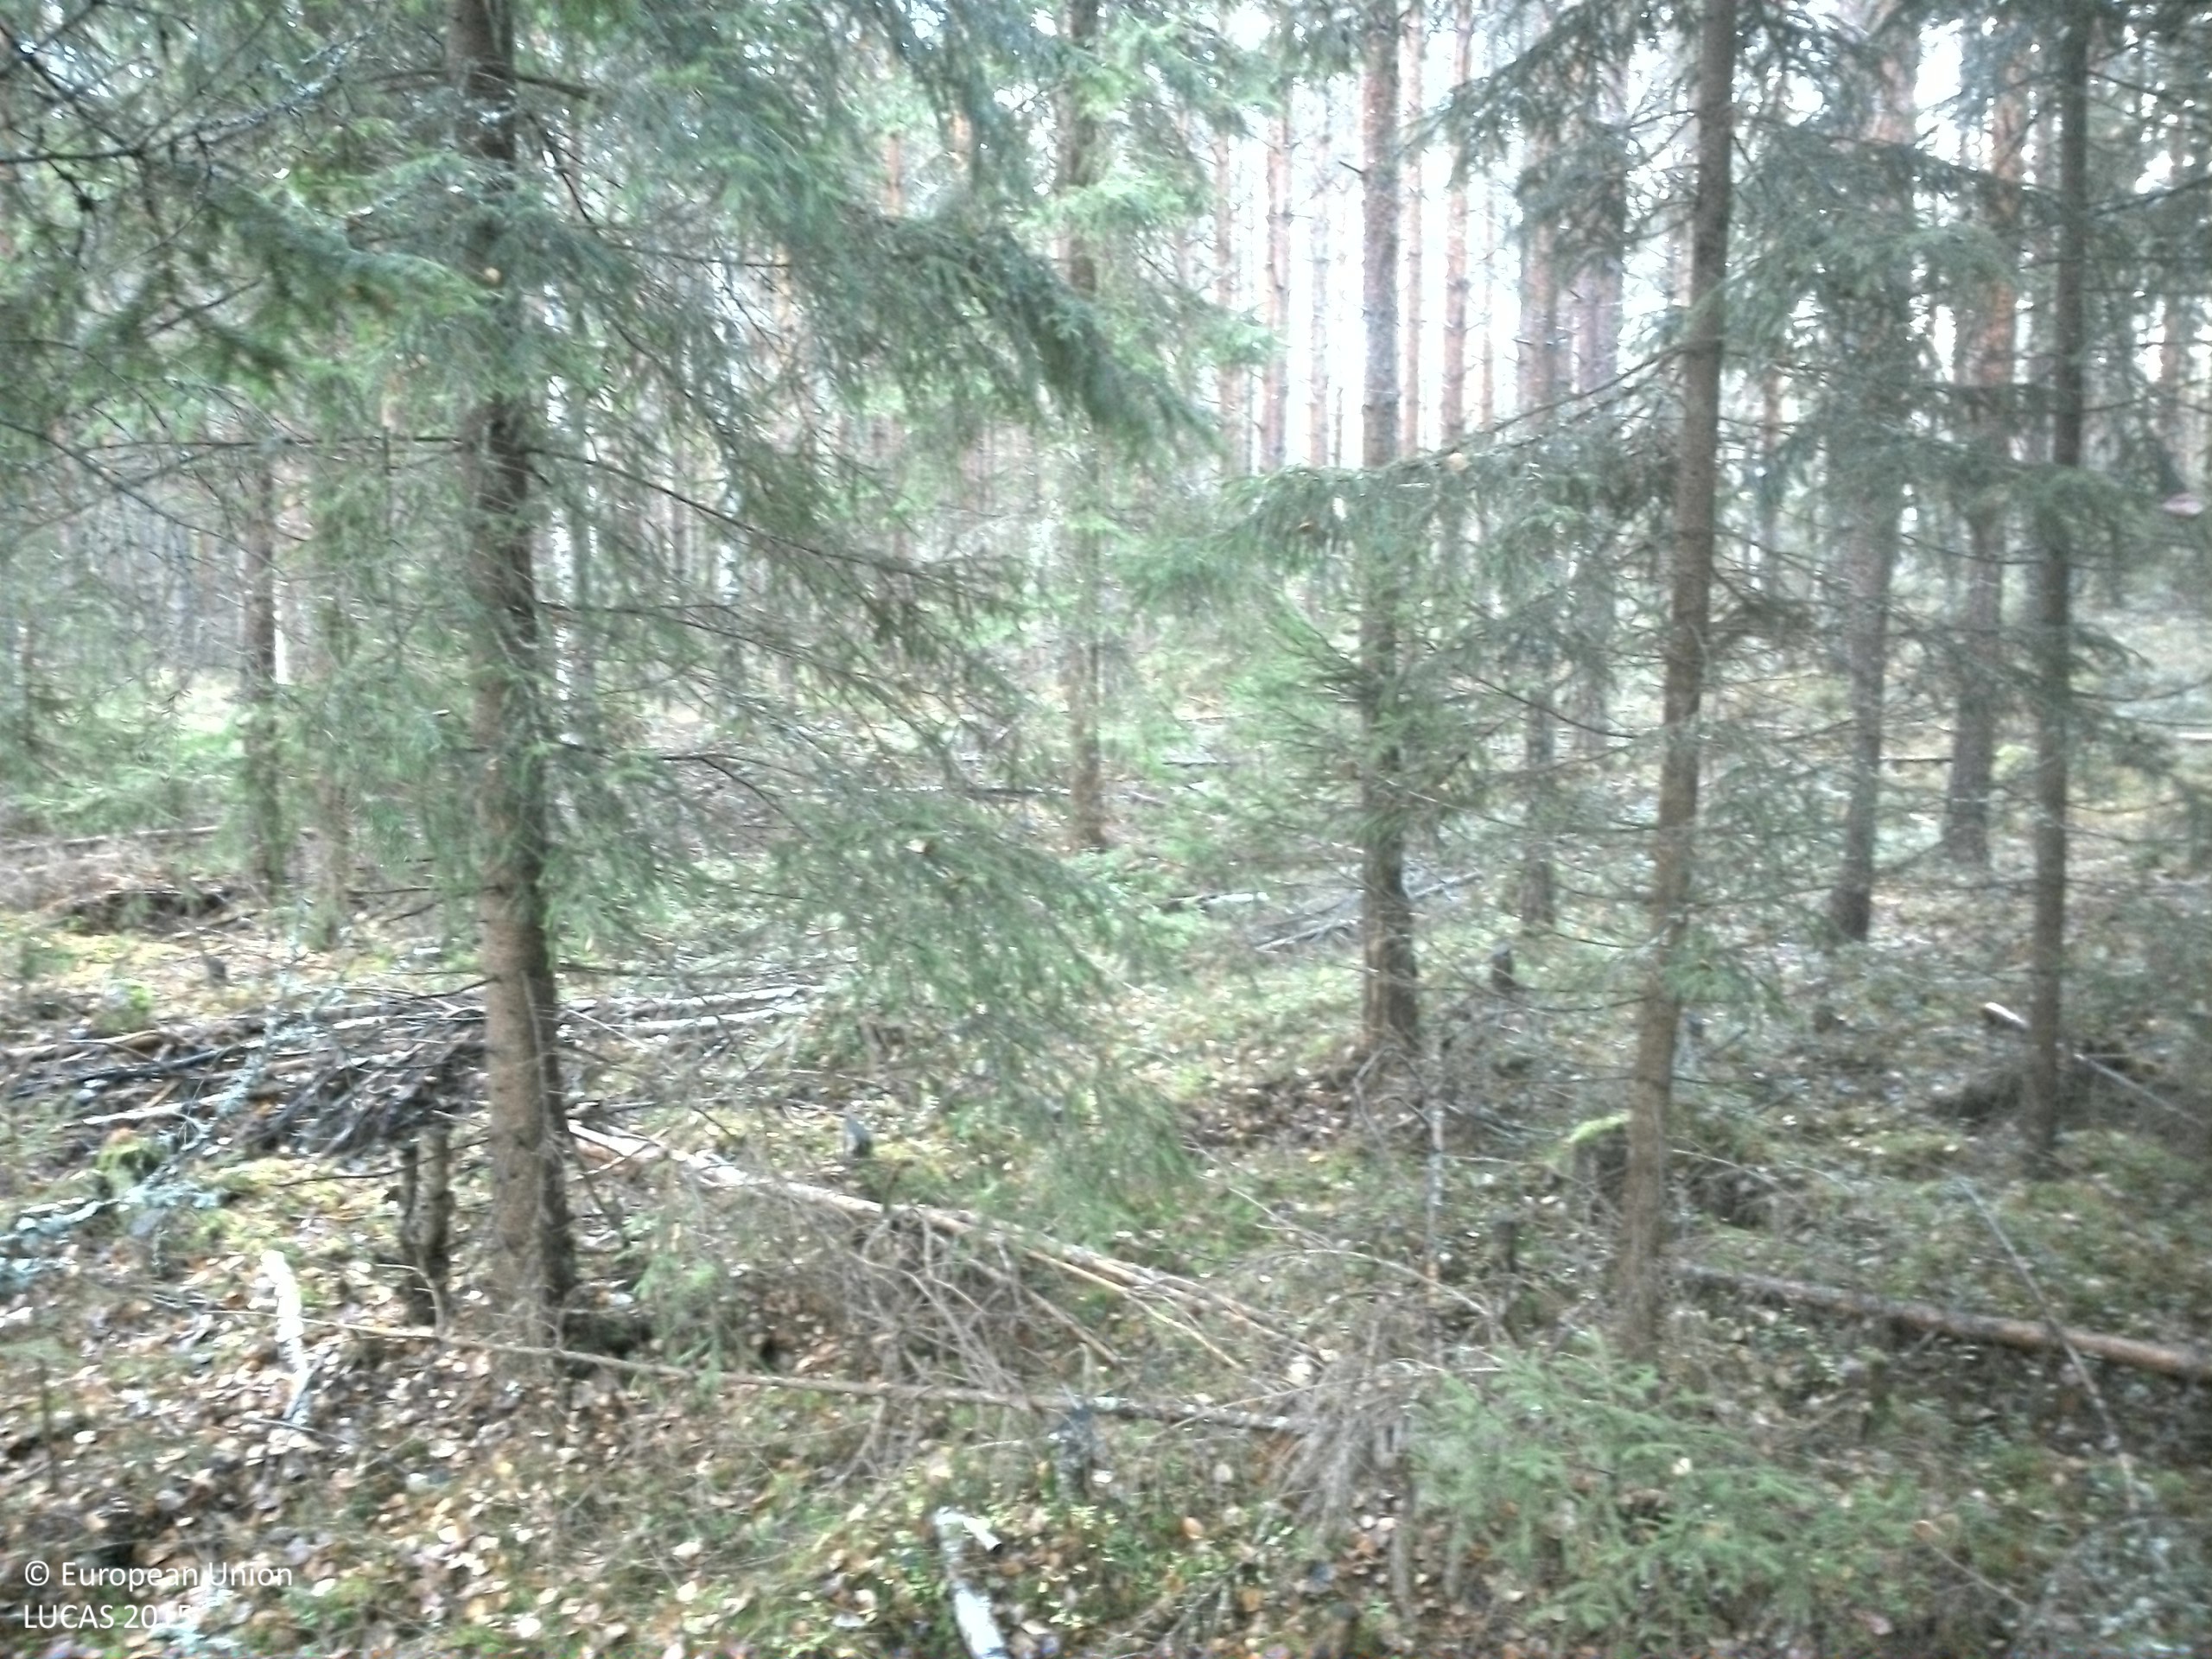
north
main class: Woodland
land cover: Spruce dominated mixed woodland
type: boreal forest
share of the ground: > 75 %
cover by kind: coniferous forest trees 55 %, broadleaved forest trees 20 %, shrubs 15 %, lichens and mosses 10 %
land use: Forestry
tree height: > 5 m
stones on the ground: < 10 %
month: October
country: SE
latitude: 59.7212
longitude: 14.7733
